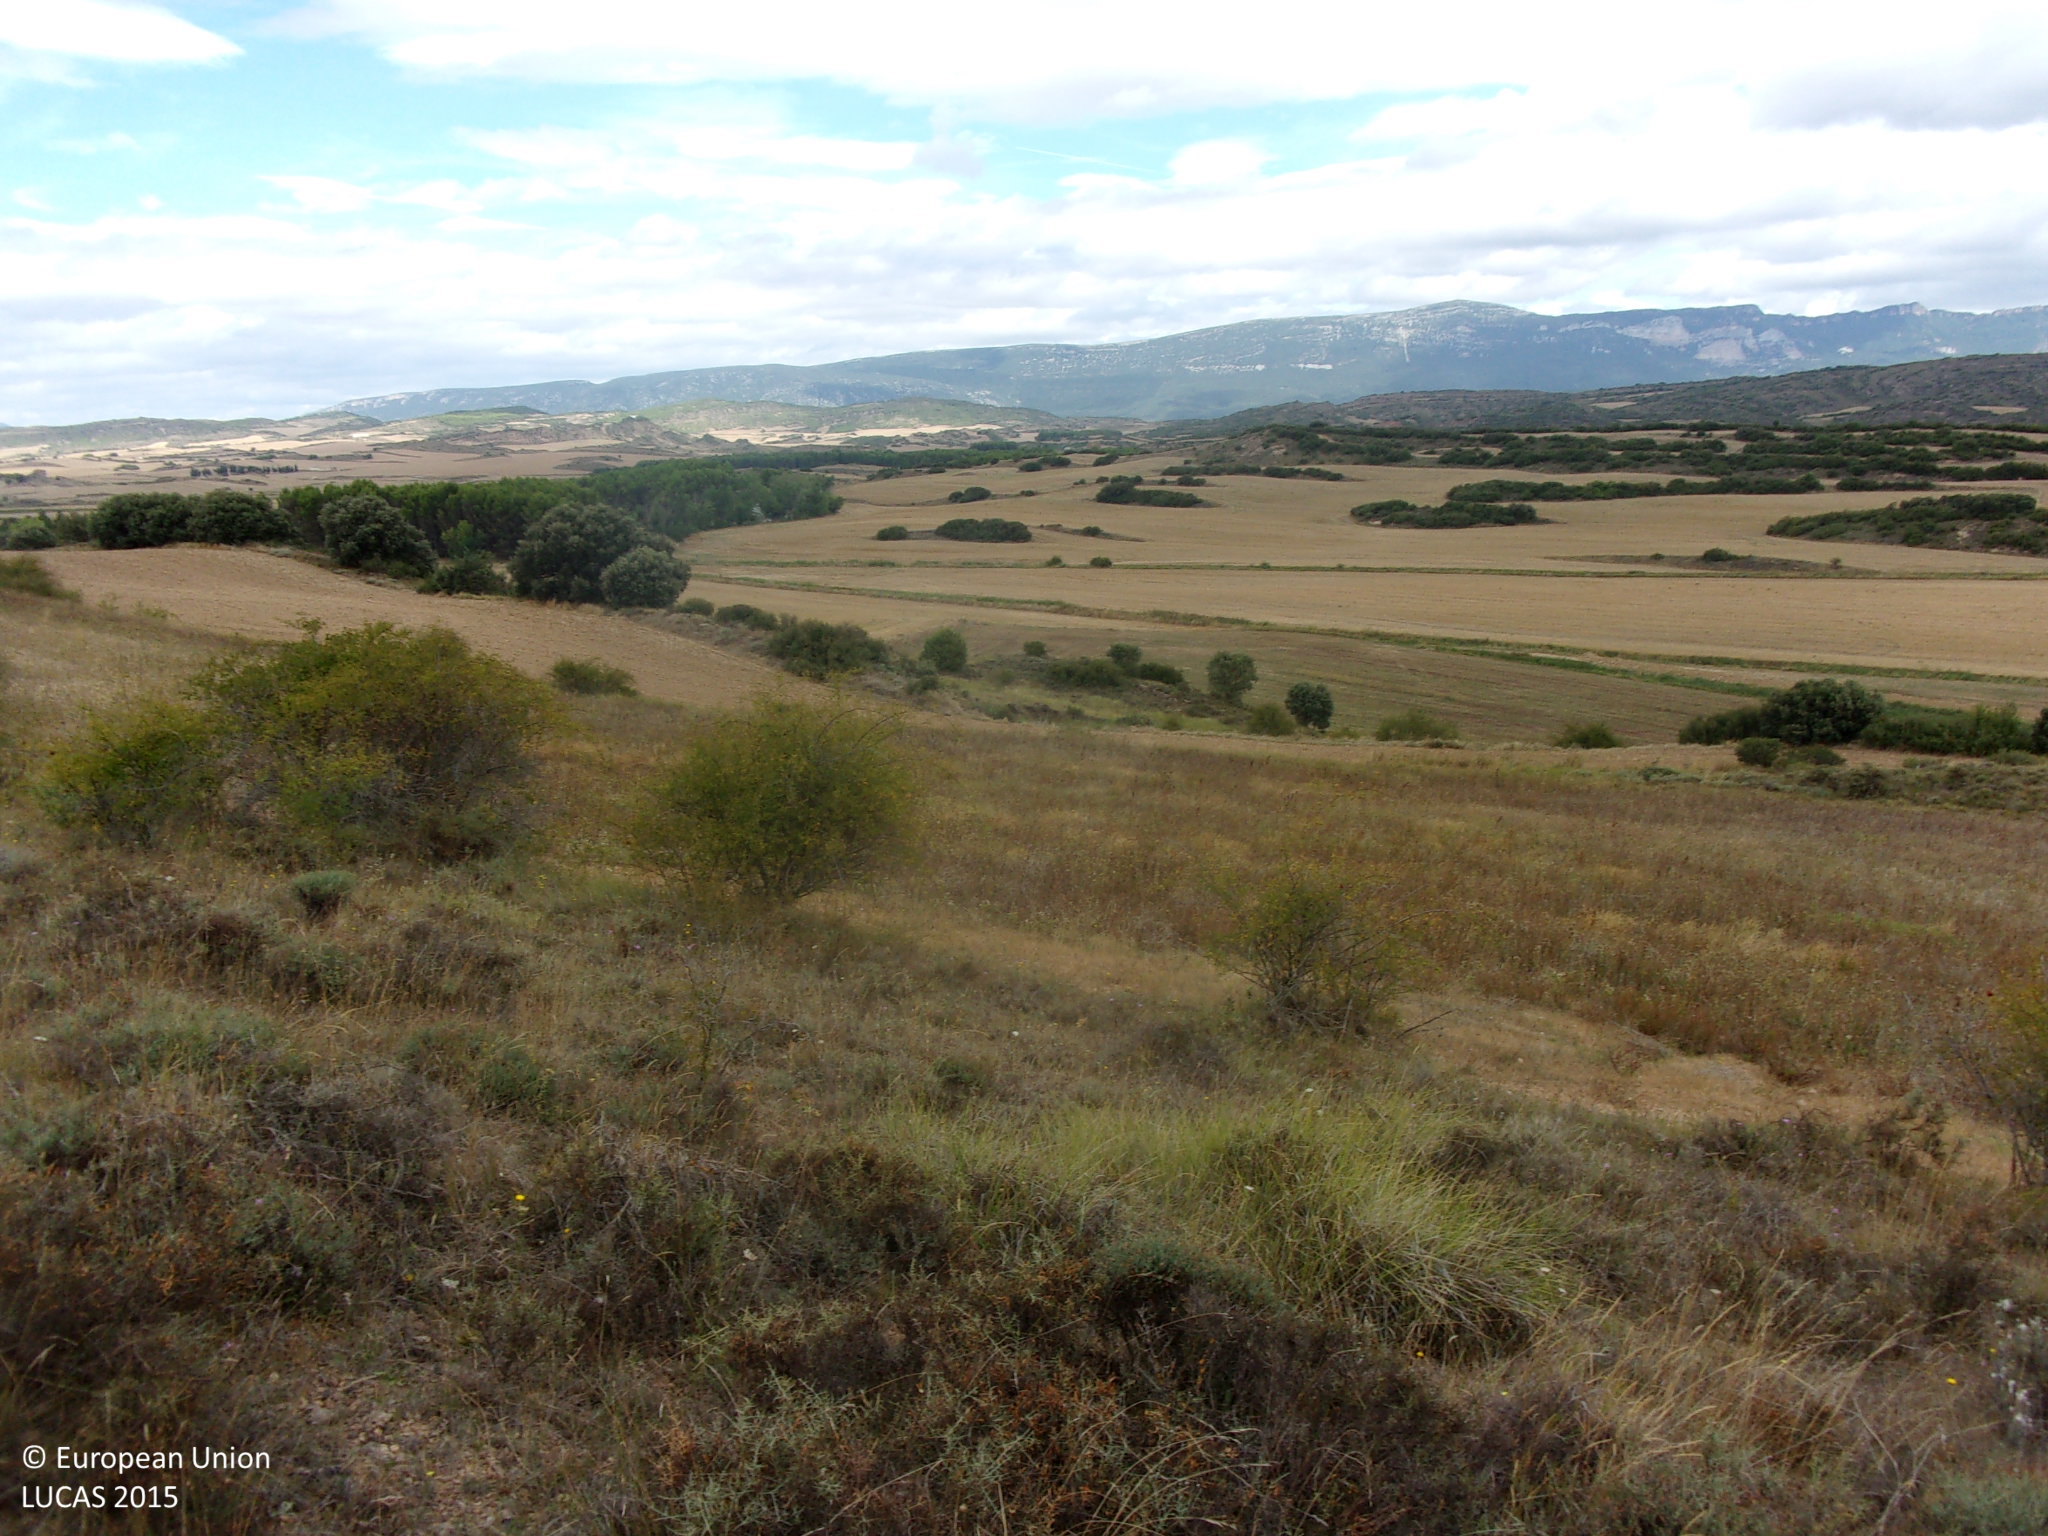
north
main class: Shrubland
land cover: Shrubland without tree cover
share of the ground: 50 - 75 %
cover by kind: shrubs 60 %, herbaceous plants 40 %
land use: Semi-natural and natural areas not in use
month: August
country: ES
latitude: 42.5410
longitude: -1.1982
